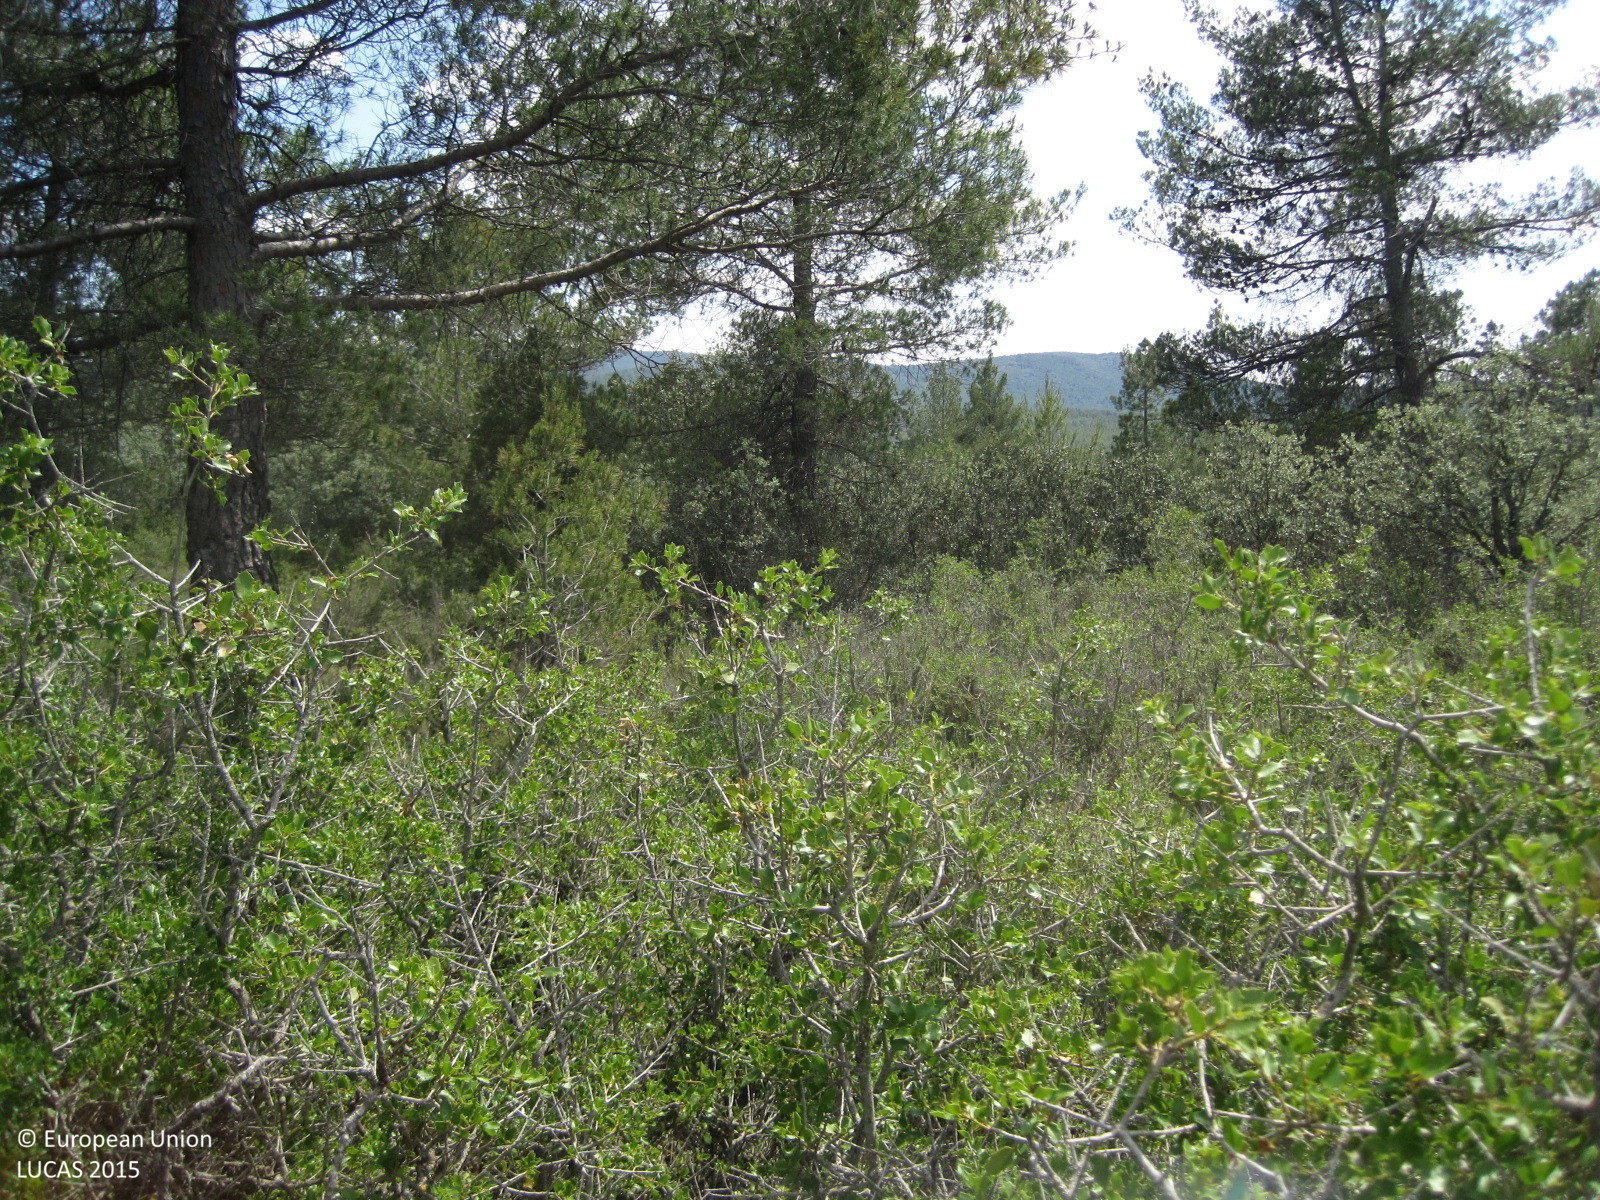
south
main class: Woodland
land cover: Pine dominated coniferous woodland
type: coniferous forest of the mediterranean region
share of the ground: 10 - 25 %
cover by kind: shrubs 80 %, coniferous forest trees 10 %, herbaceous plants 10 %
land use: Forestry
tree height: > 5 m
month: June
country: ES
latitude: 39.7188
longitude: -1.1683
